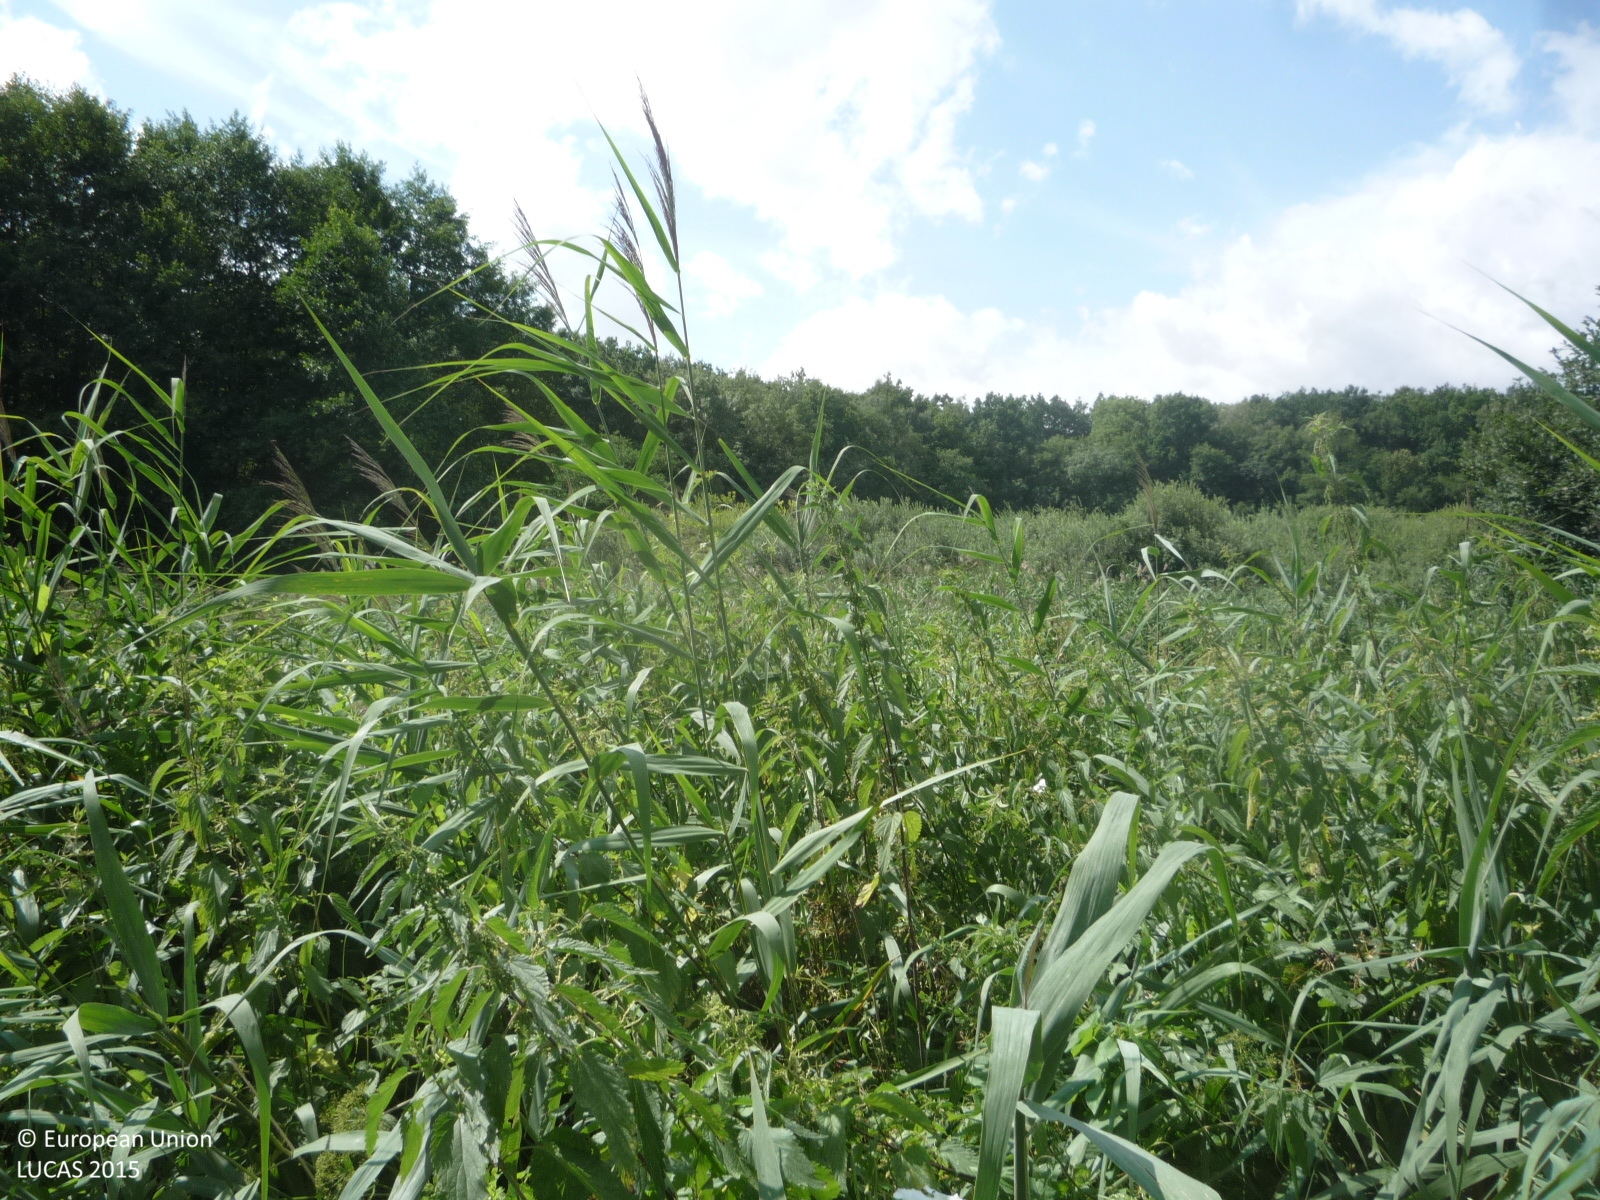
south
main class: Grassland
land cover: Spontaneously vegetated surfaces
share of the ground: > 75 %
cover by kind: herbaceous plants 100 %
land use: Semi-natural and natural areas not in use
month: July
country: CZ
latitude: 50.3365
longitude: 15.1876
